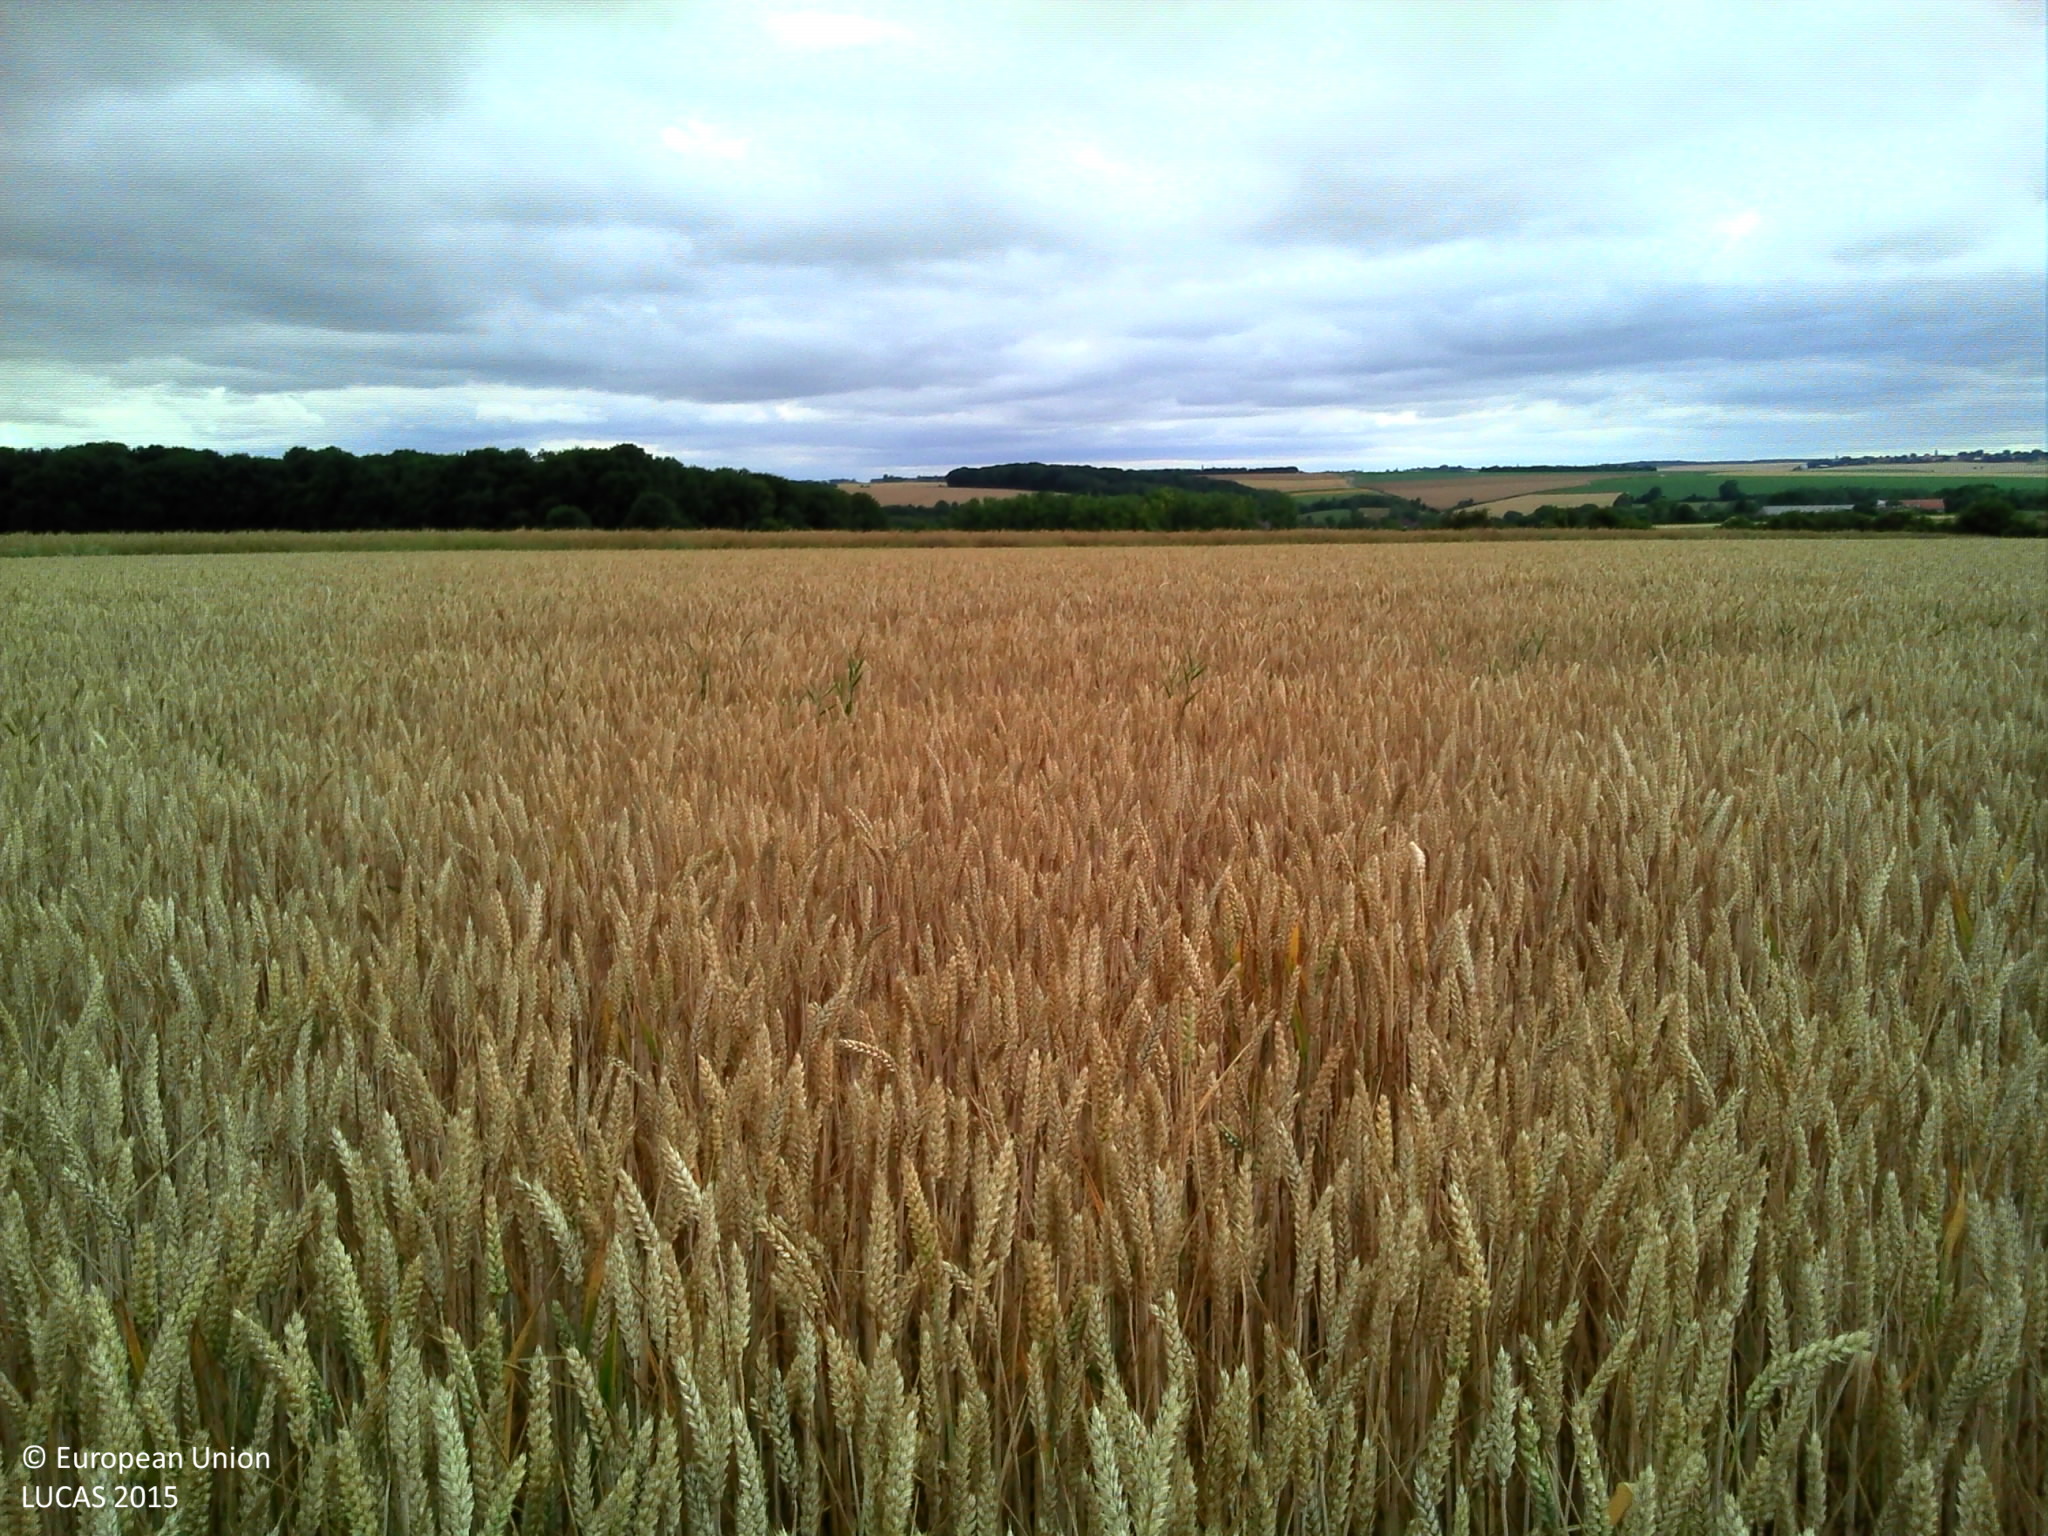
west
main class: Cropland
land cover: Common wheat
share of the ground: > 75 %
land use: Agriculture (excluding fallow land and kitchen gardens)
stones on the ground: < 10 %
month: July
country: FR
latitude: 50.0365
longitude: 3.2198
